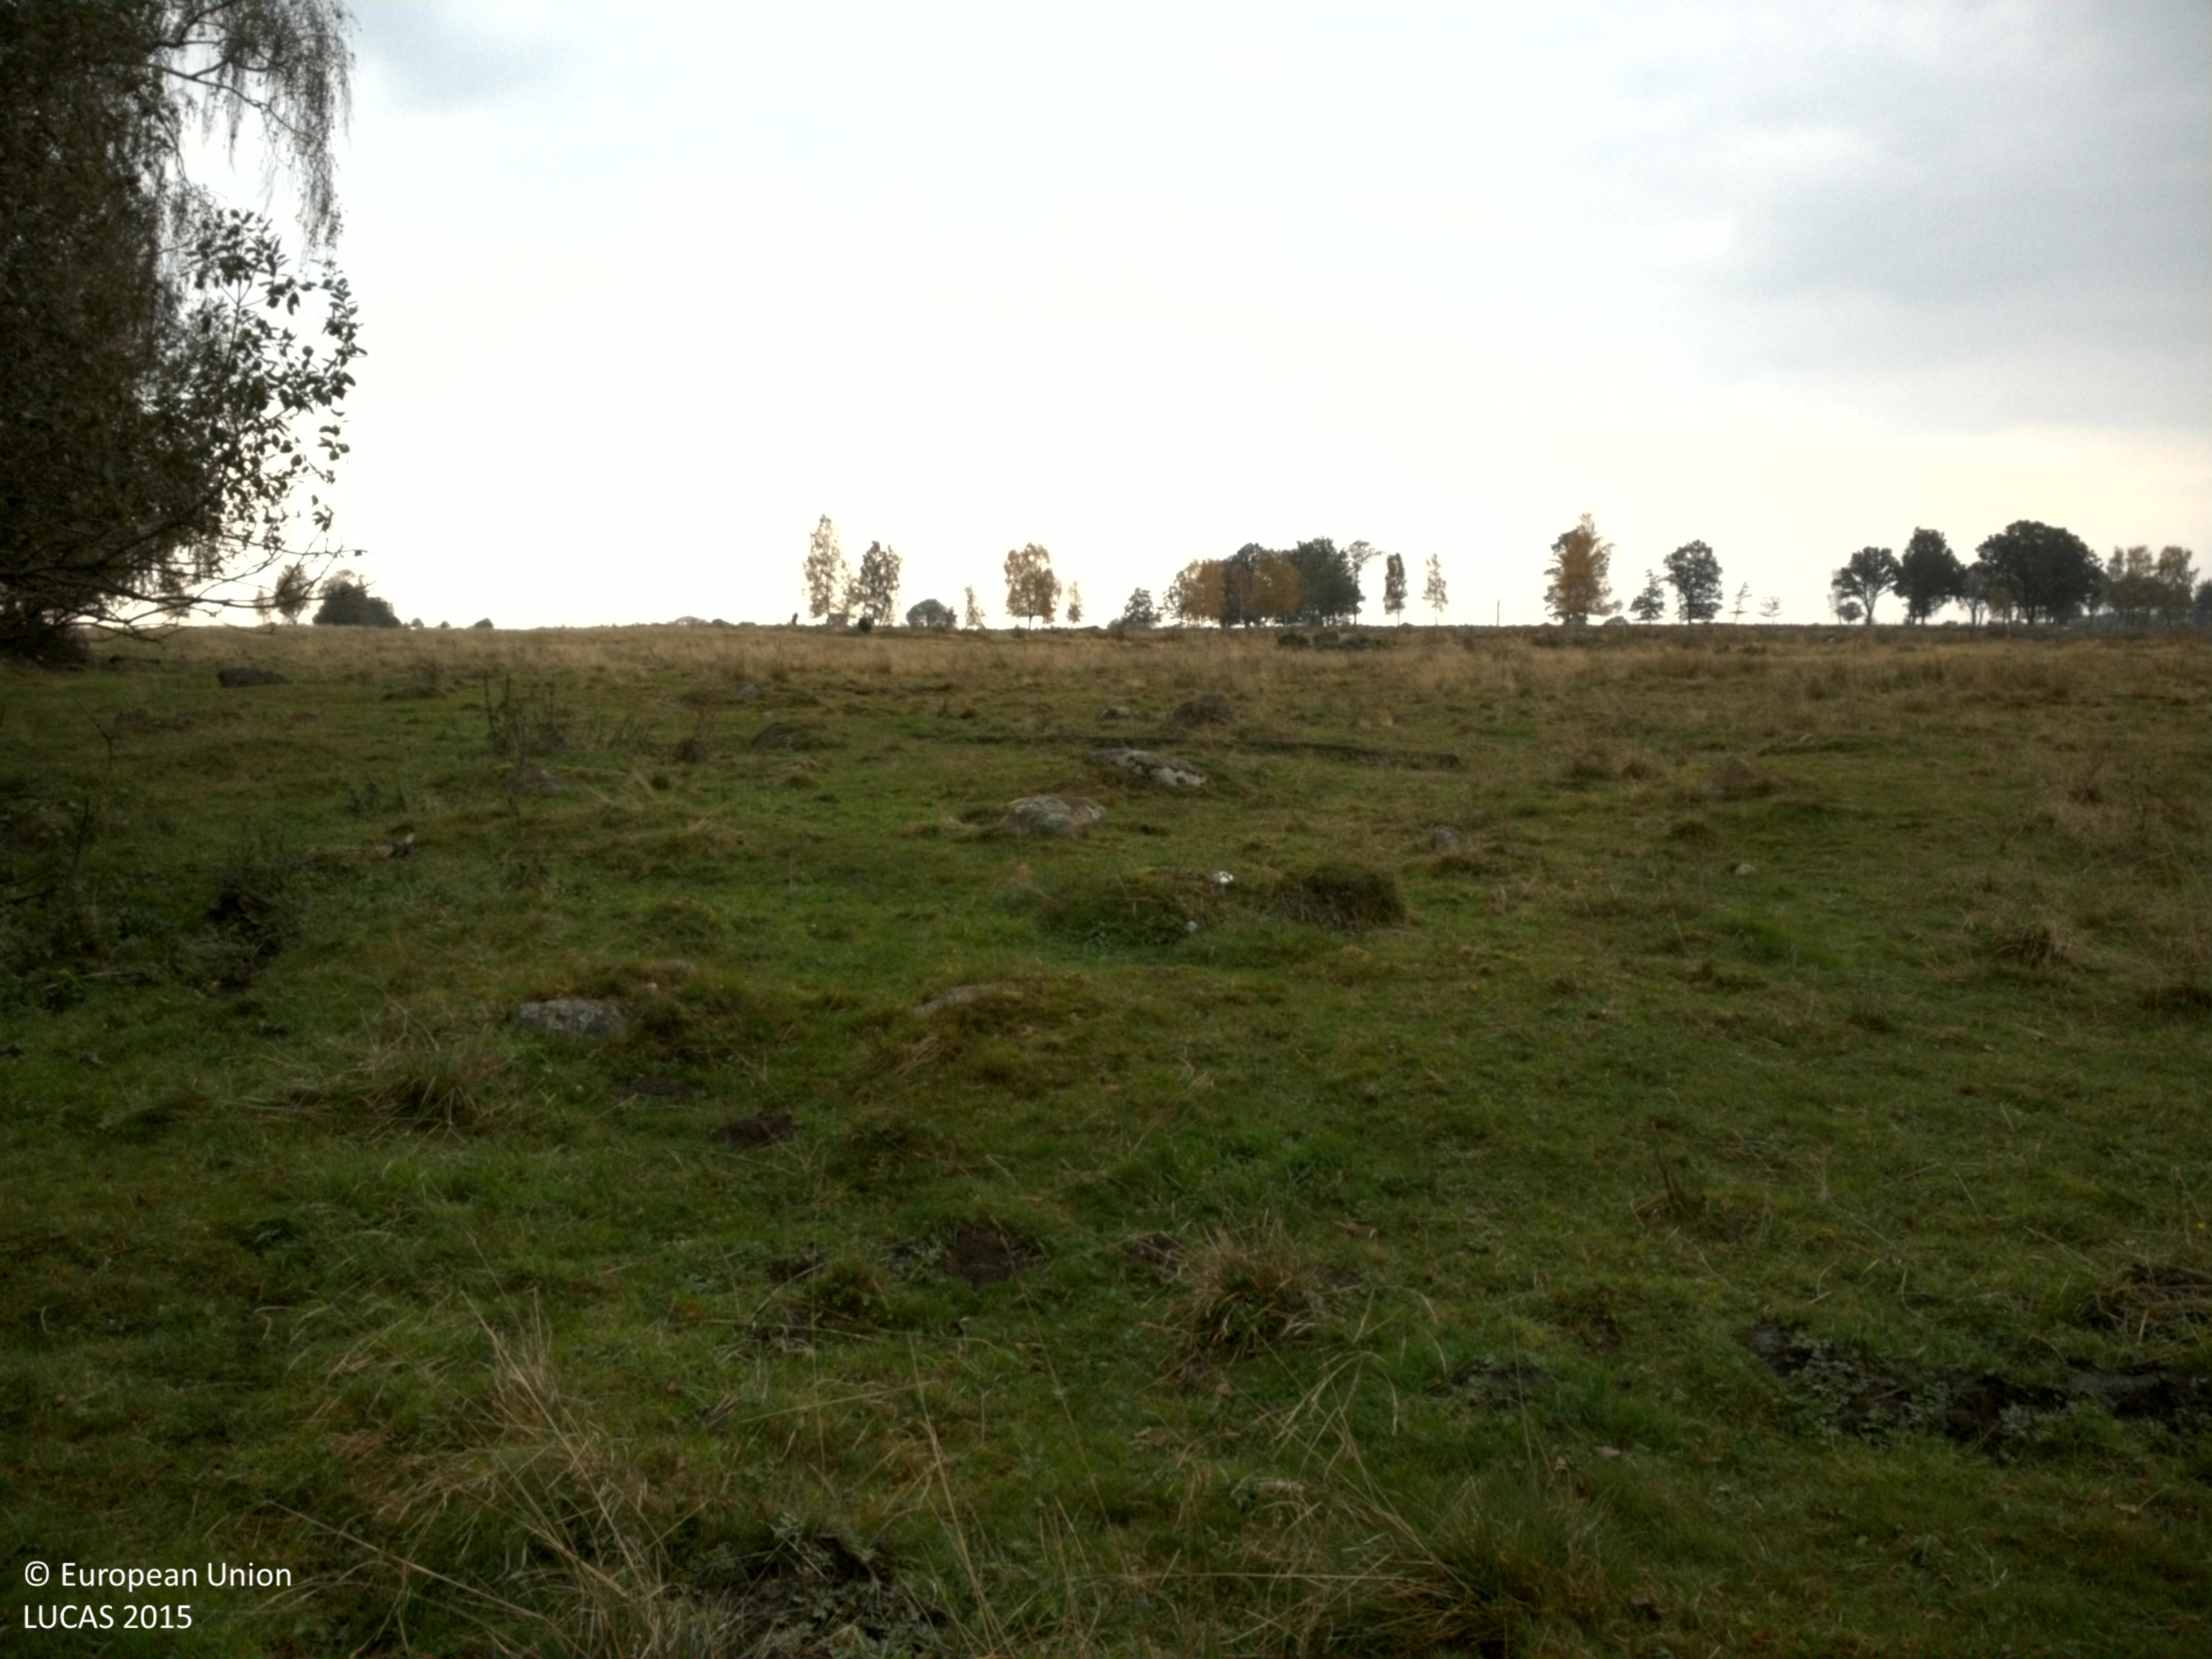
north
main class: Grassland
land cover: Grassland without tree/shrub cover
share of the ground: > 75 %
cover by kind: herbaceous plants 100 %
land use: Agriculture (excluding fallow land and kitchen gardens)
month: October
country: SE
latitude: 55.8101
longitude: 13.7158
